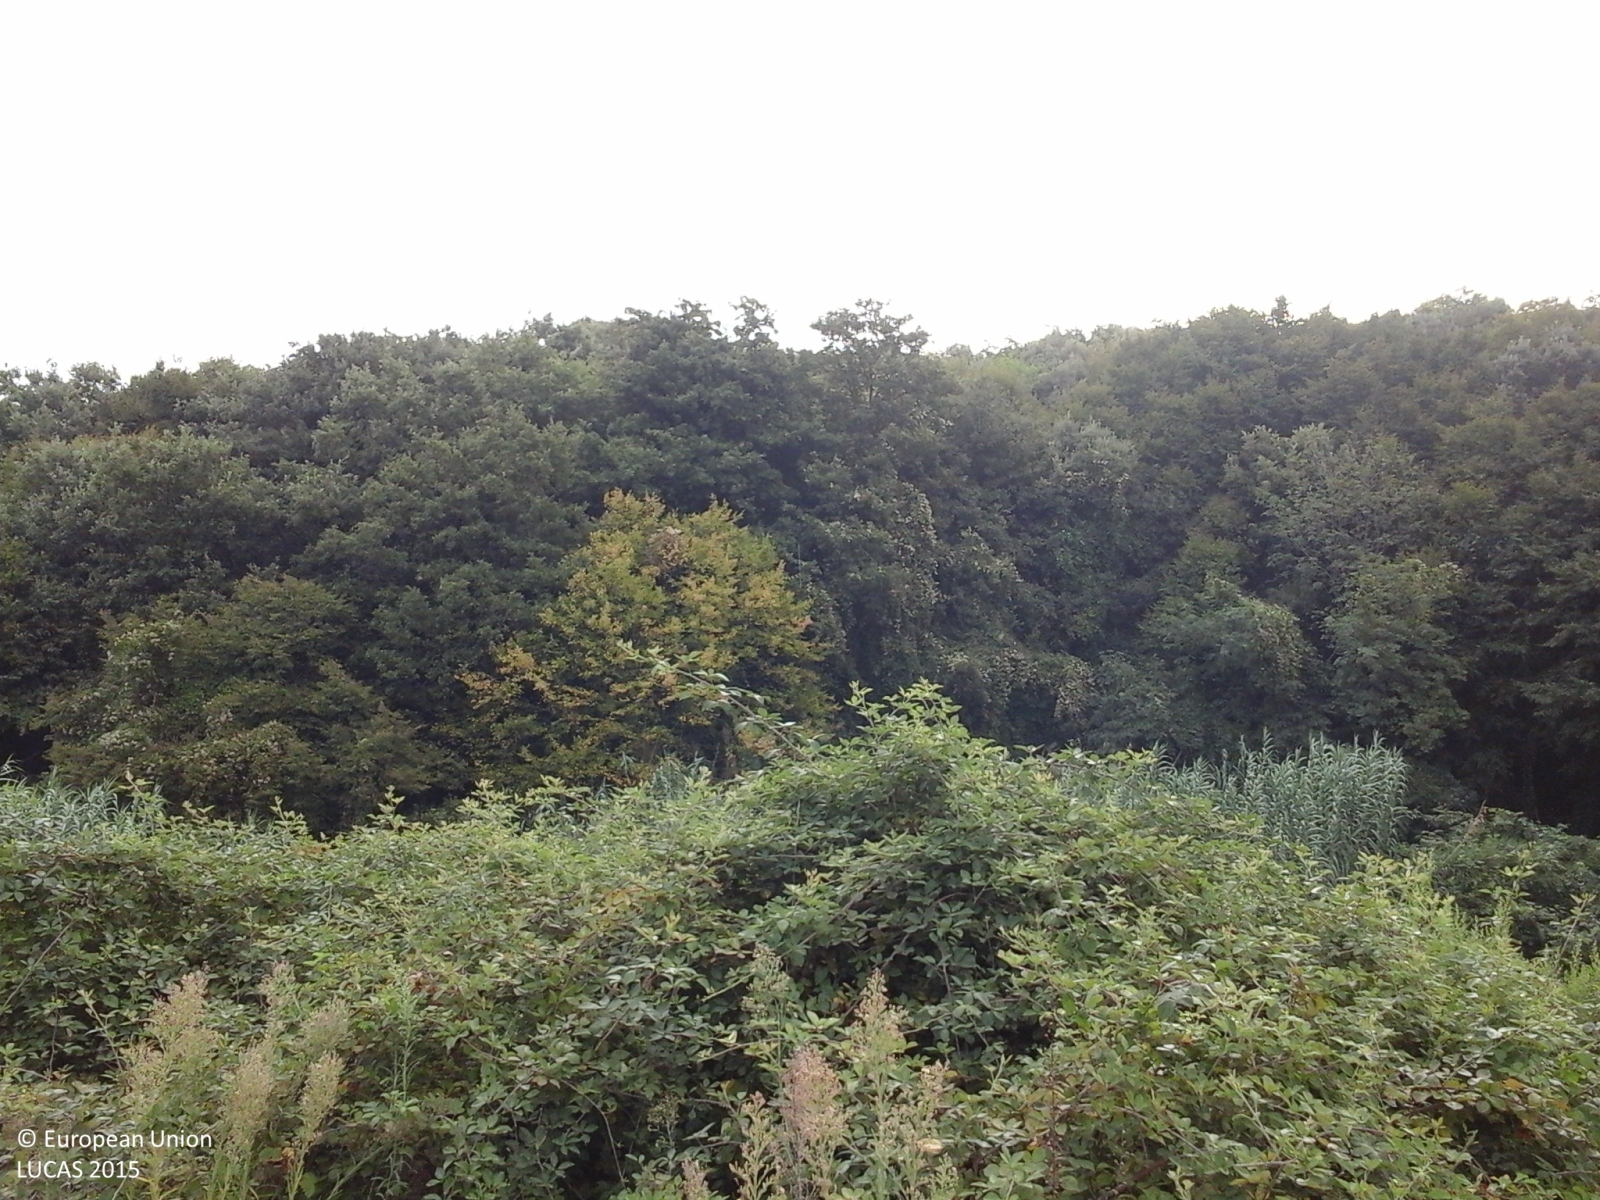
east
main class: Shrubland
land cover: Shrubland without tree cover
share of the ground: > 75 %
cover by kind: shrubs 95 %, herbaceous plants 5 %
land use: Semi-natural and natural areas not in use
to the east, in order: Shrubland without tree cover; Inland fresh running water; Broadleaved woodland; Barley
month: September
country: IT
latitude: 41.8688
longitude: 15.2009
